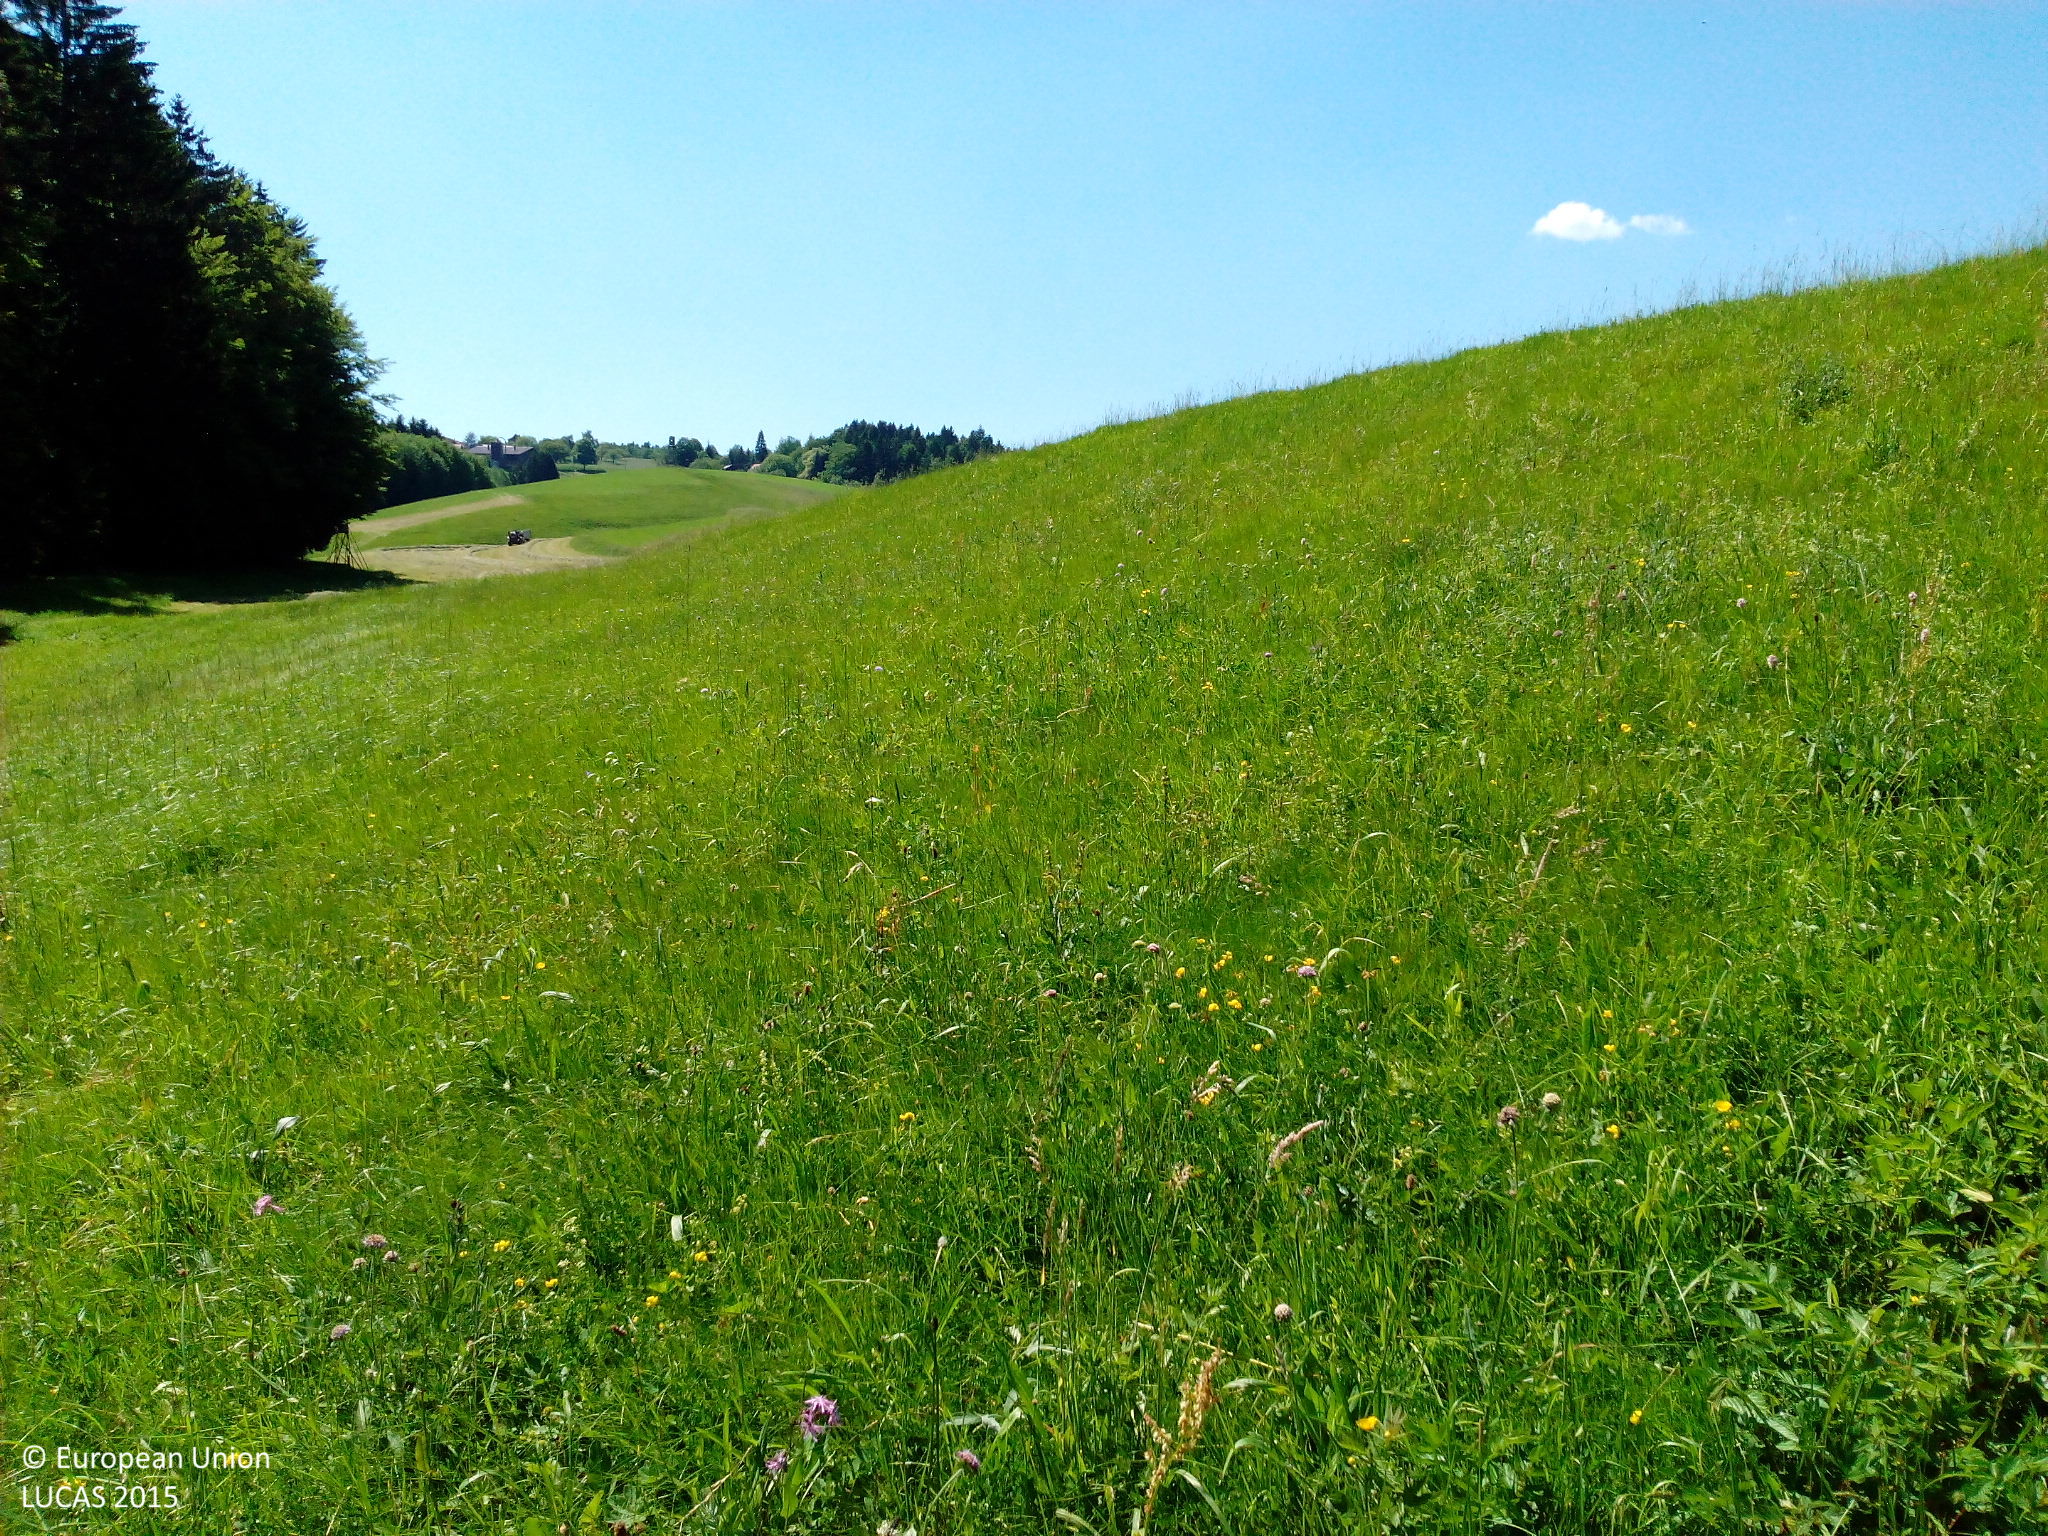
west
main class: Grassland
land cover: Grassland without tree/shrub cover
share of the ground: > 75 %
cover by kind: herbaceous plants 100 %
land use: Agriculture (excluding fallow land and kitchen gardens)
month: June
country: DE
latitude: 48.9248
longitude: 9.6862
